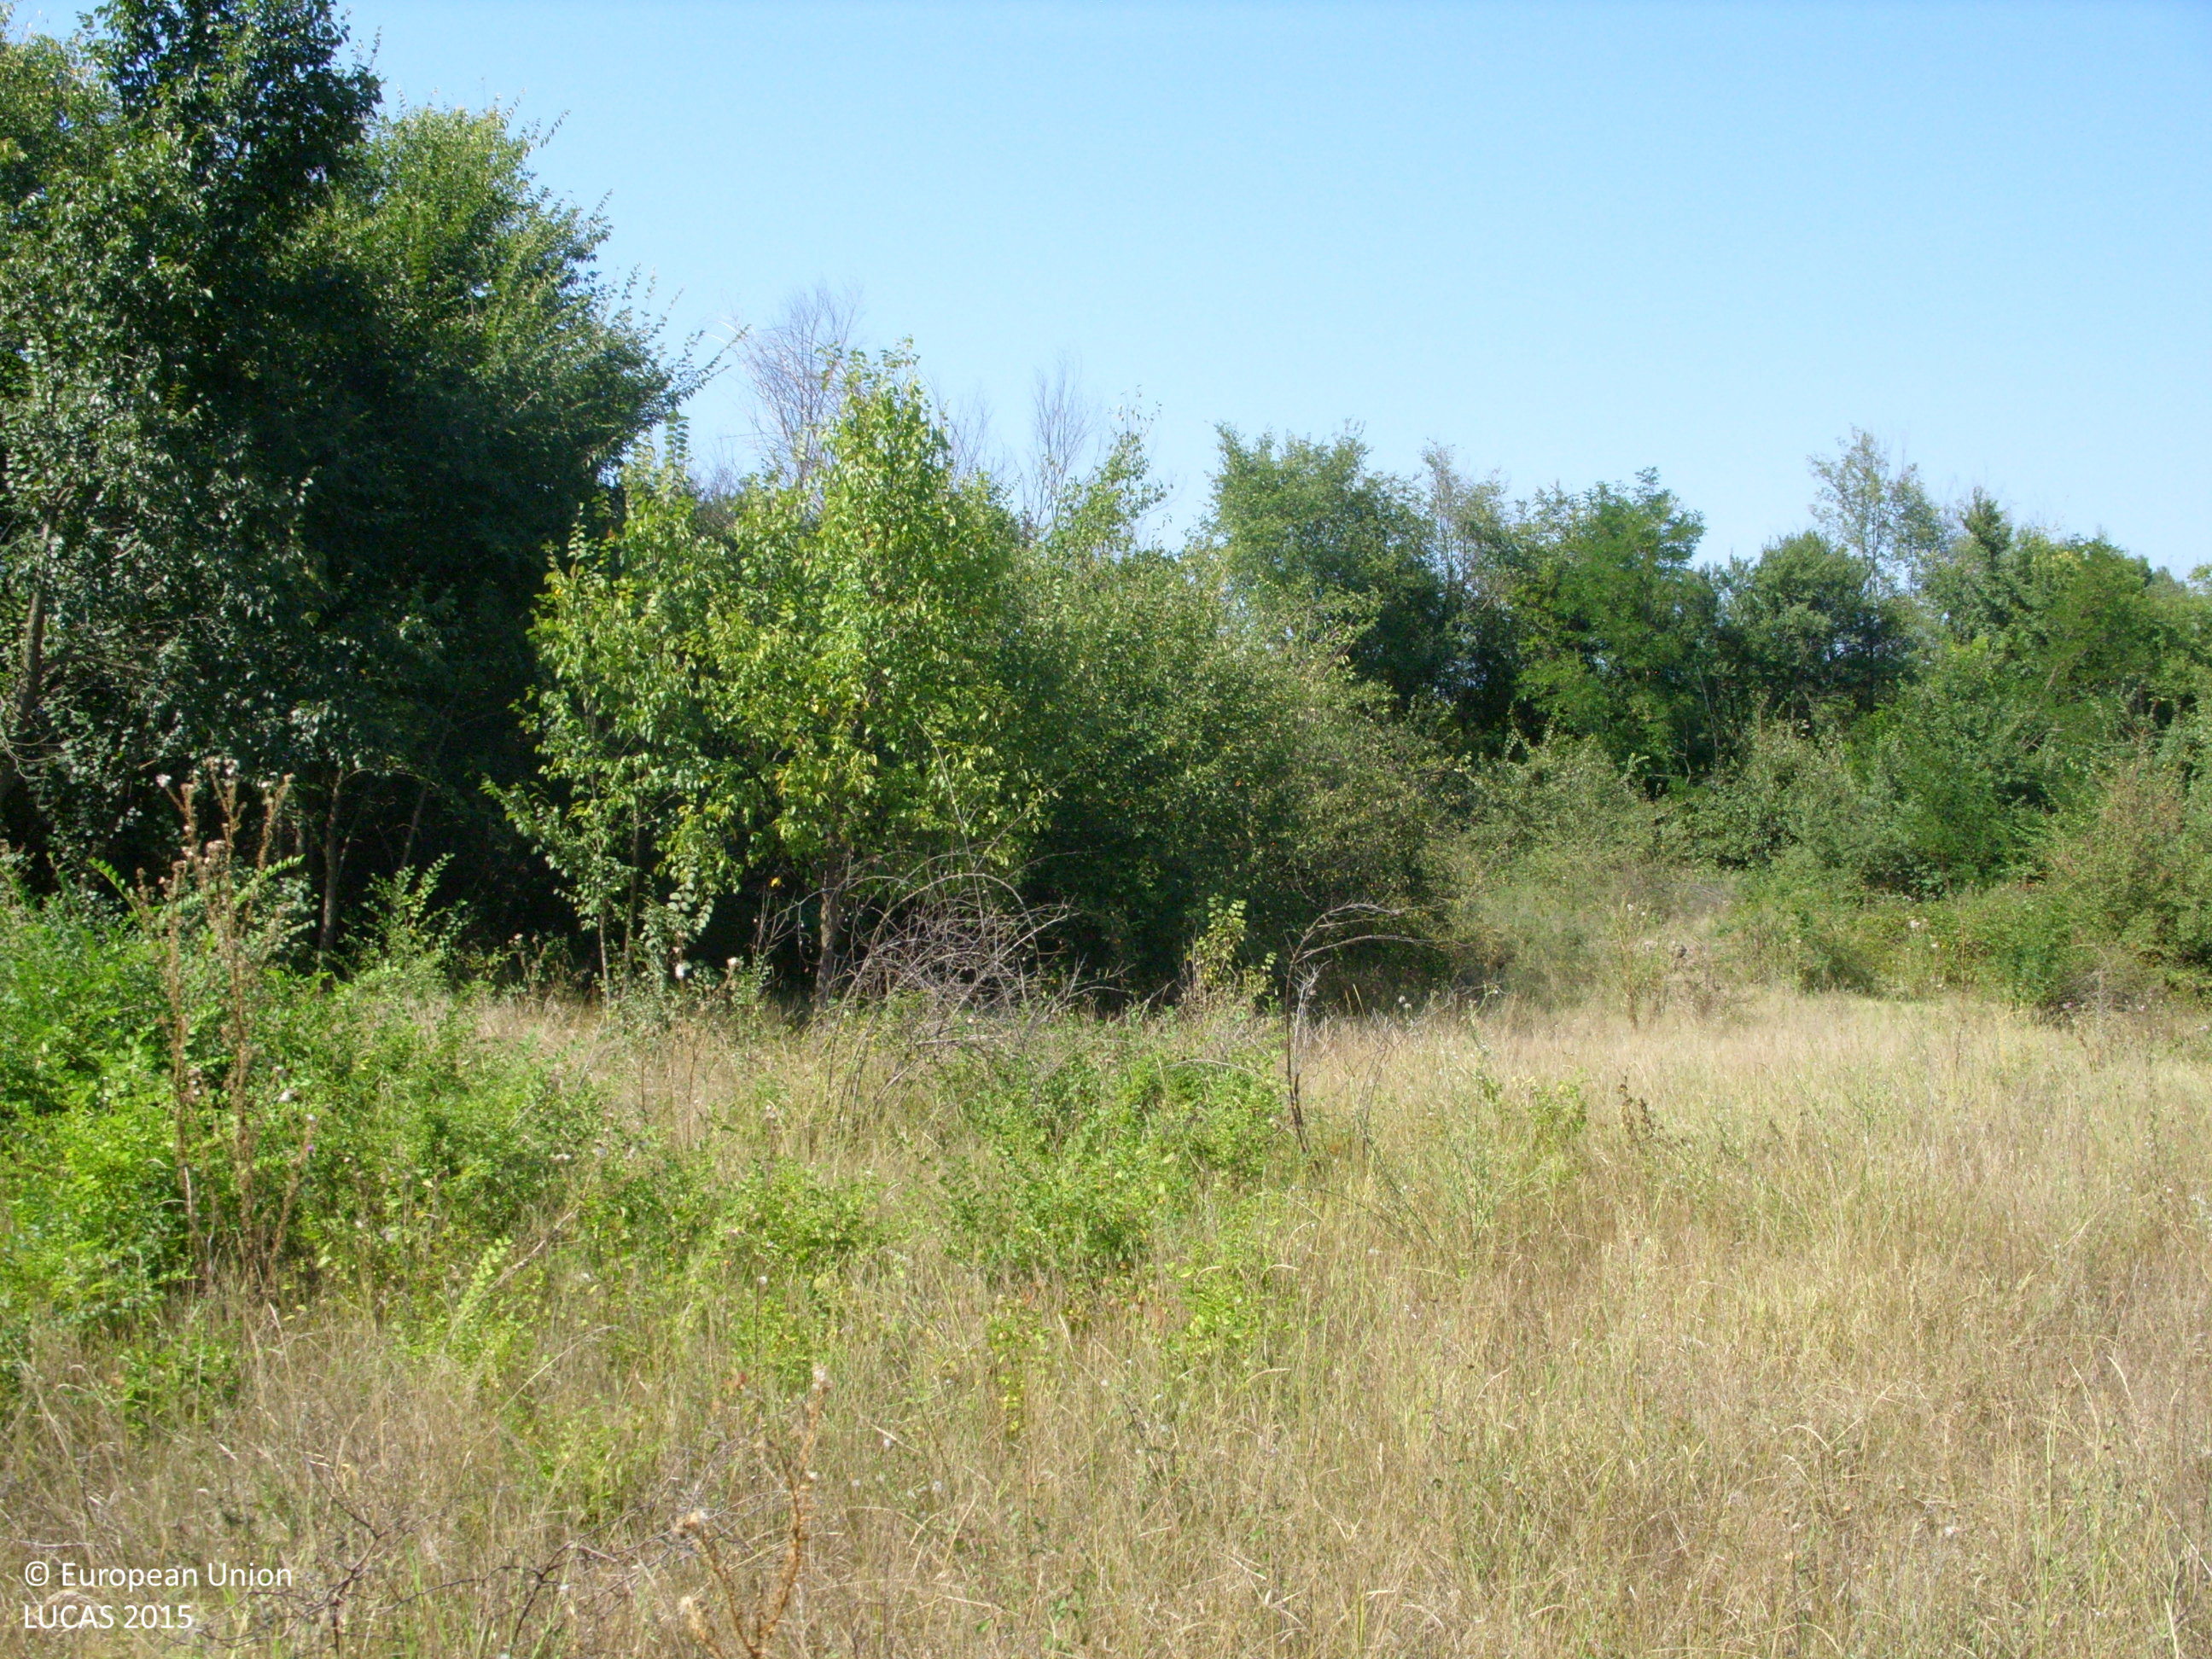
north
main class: Grassland
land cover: Grassland with sparse tree/shrub cover
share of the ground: > 75 %
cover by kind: herbaceous plants 90 %, broadleaved forest trees 5 %, shrubs 5 %
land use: Water supply and treatment
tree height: < 5 m
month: August
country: BG
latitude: 42.3788
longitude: 25.0839
